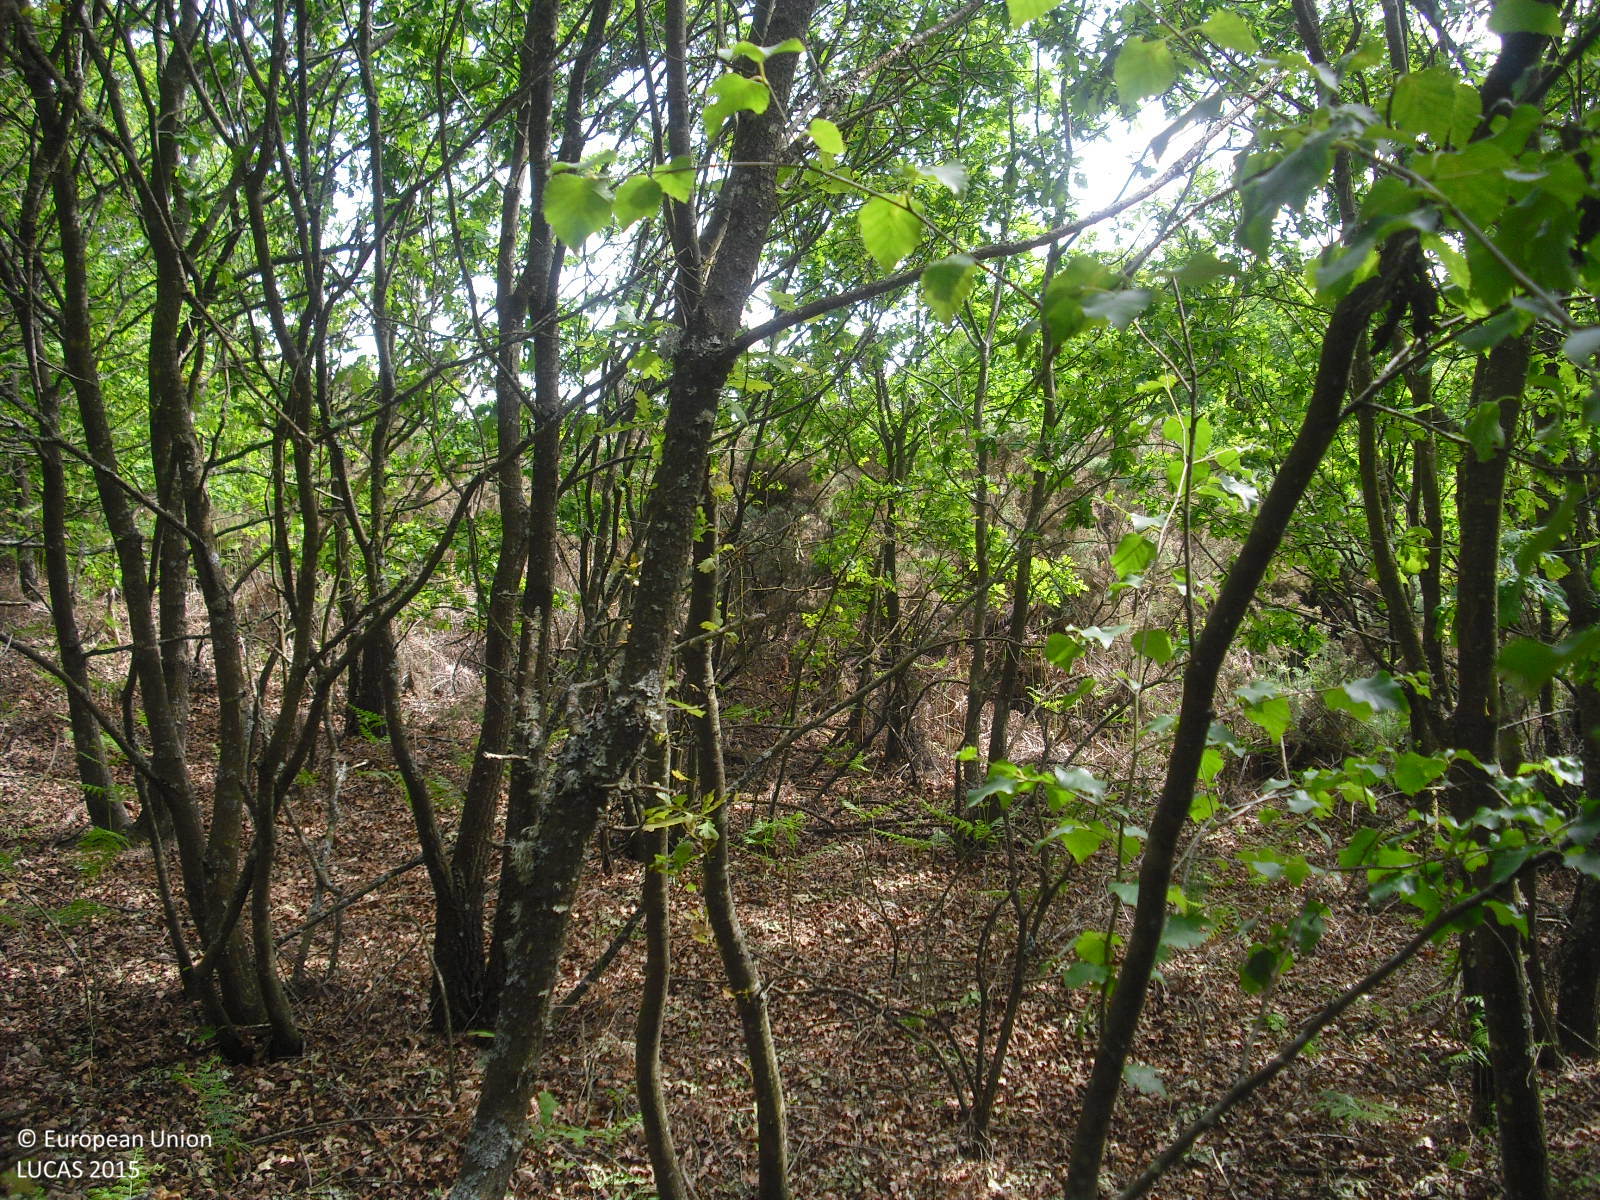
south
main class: Woodland
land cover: Broadleaved woodland
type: acidophilous oak and oak-birch forest
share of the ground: 50 - 75 %
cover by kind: broadleaved forest trees 60 %, shrubs 40 %
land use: Semi-natural and natural areas not in use
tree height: > 5 m
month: May
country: ES
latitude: 42.1548
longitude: -7.7776
